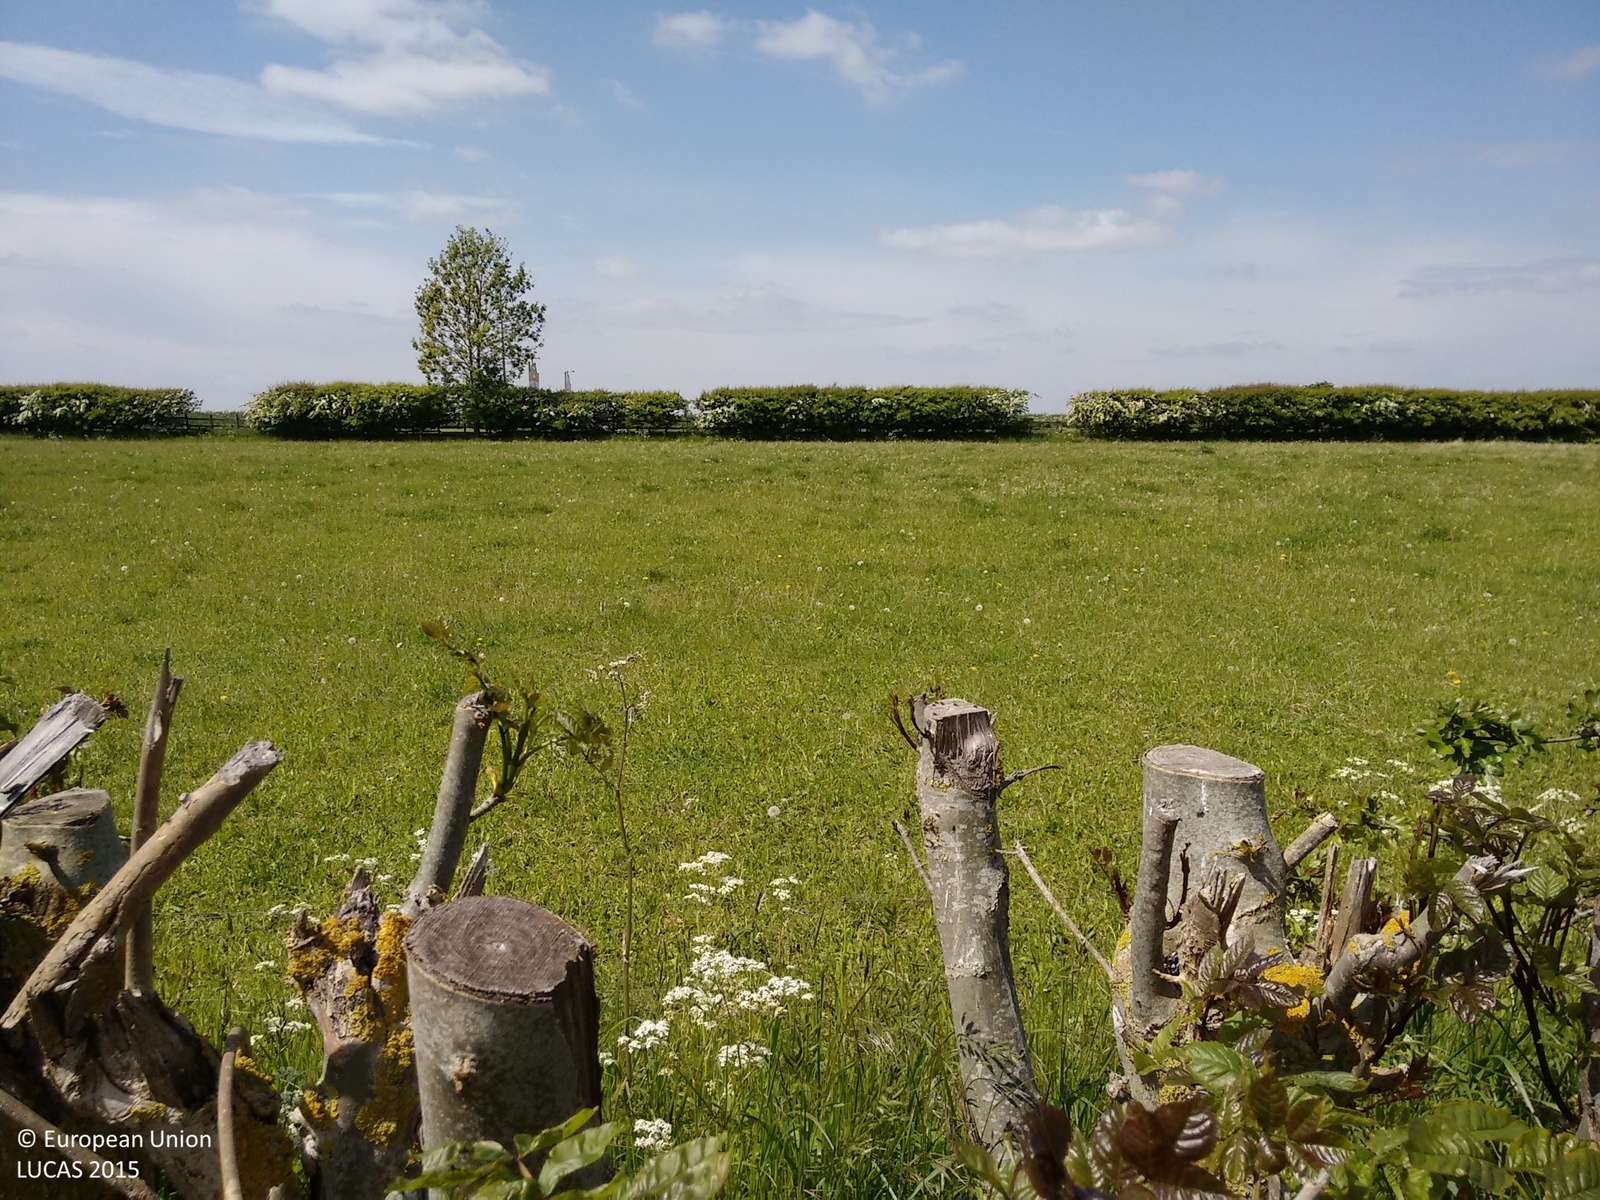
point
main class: Grassland
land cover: Grassland without tree/shrub cover
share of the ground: > 75 %
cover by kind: herbaceous plants 100 %
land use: Agriculture (excluding fallow land and kitchen gardens)
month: May
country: GB
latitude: 53.5141
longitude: -0.8236
